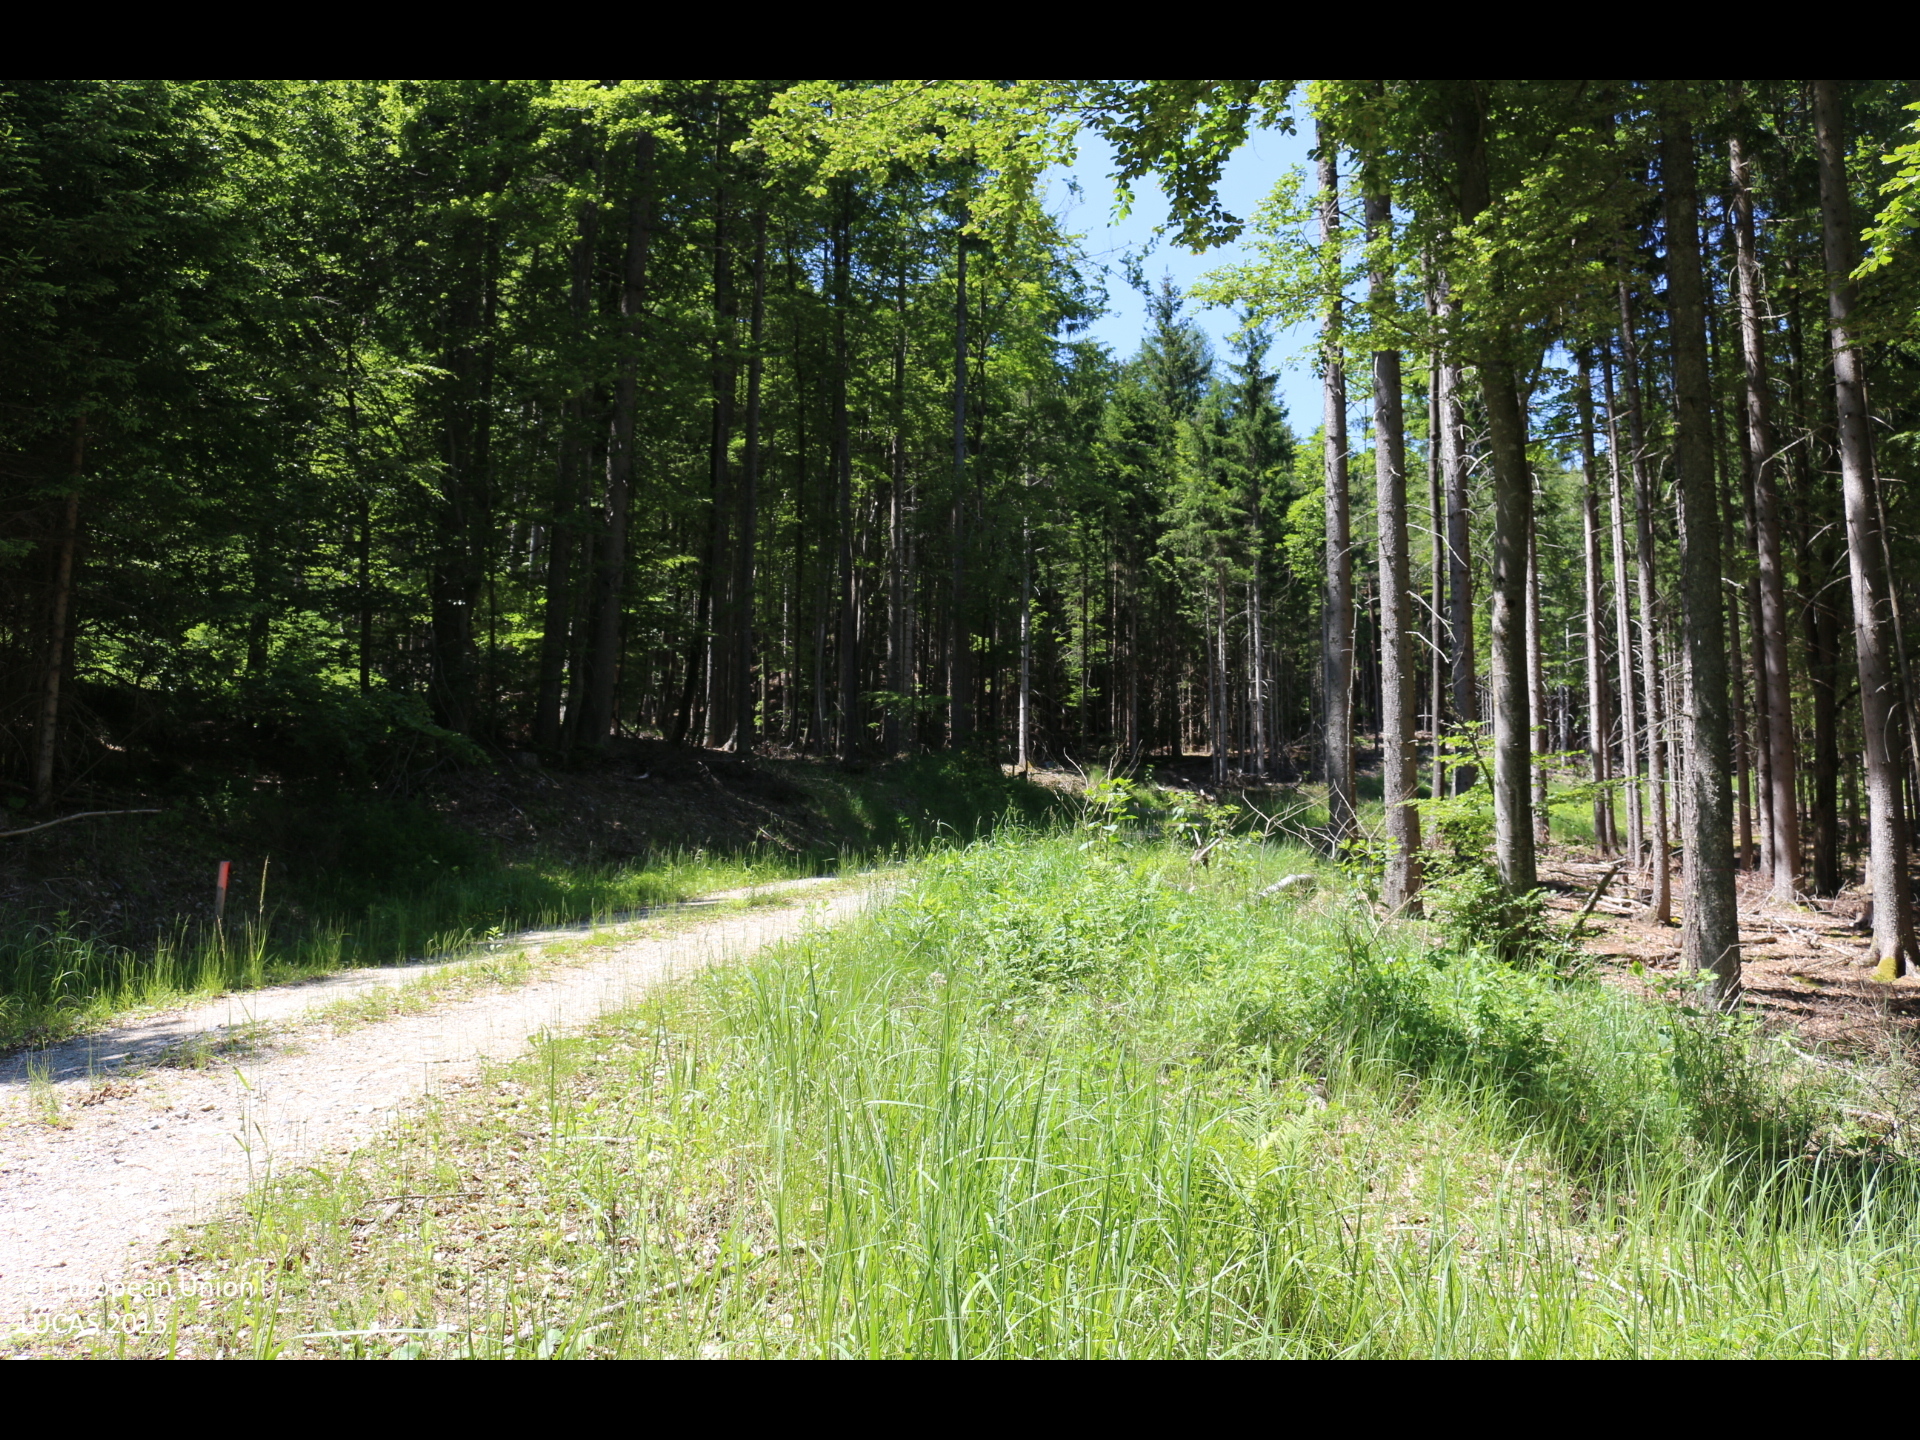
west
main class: Woodland
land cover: Spruce dominated mixed woodland
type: mountainous beech forest
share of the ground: > 75 %
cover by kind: coniferous forest trees 60 %, broadleaved forest trees 35 %, herbaceous plants 5 %
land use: Forestry
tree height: > 5 m
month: May
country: AT
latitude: 46.5279
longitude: 14.0255
